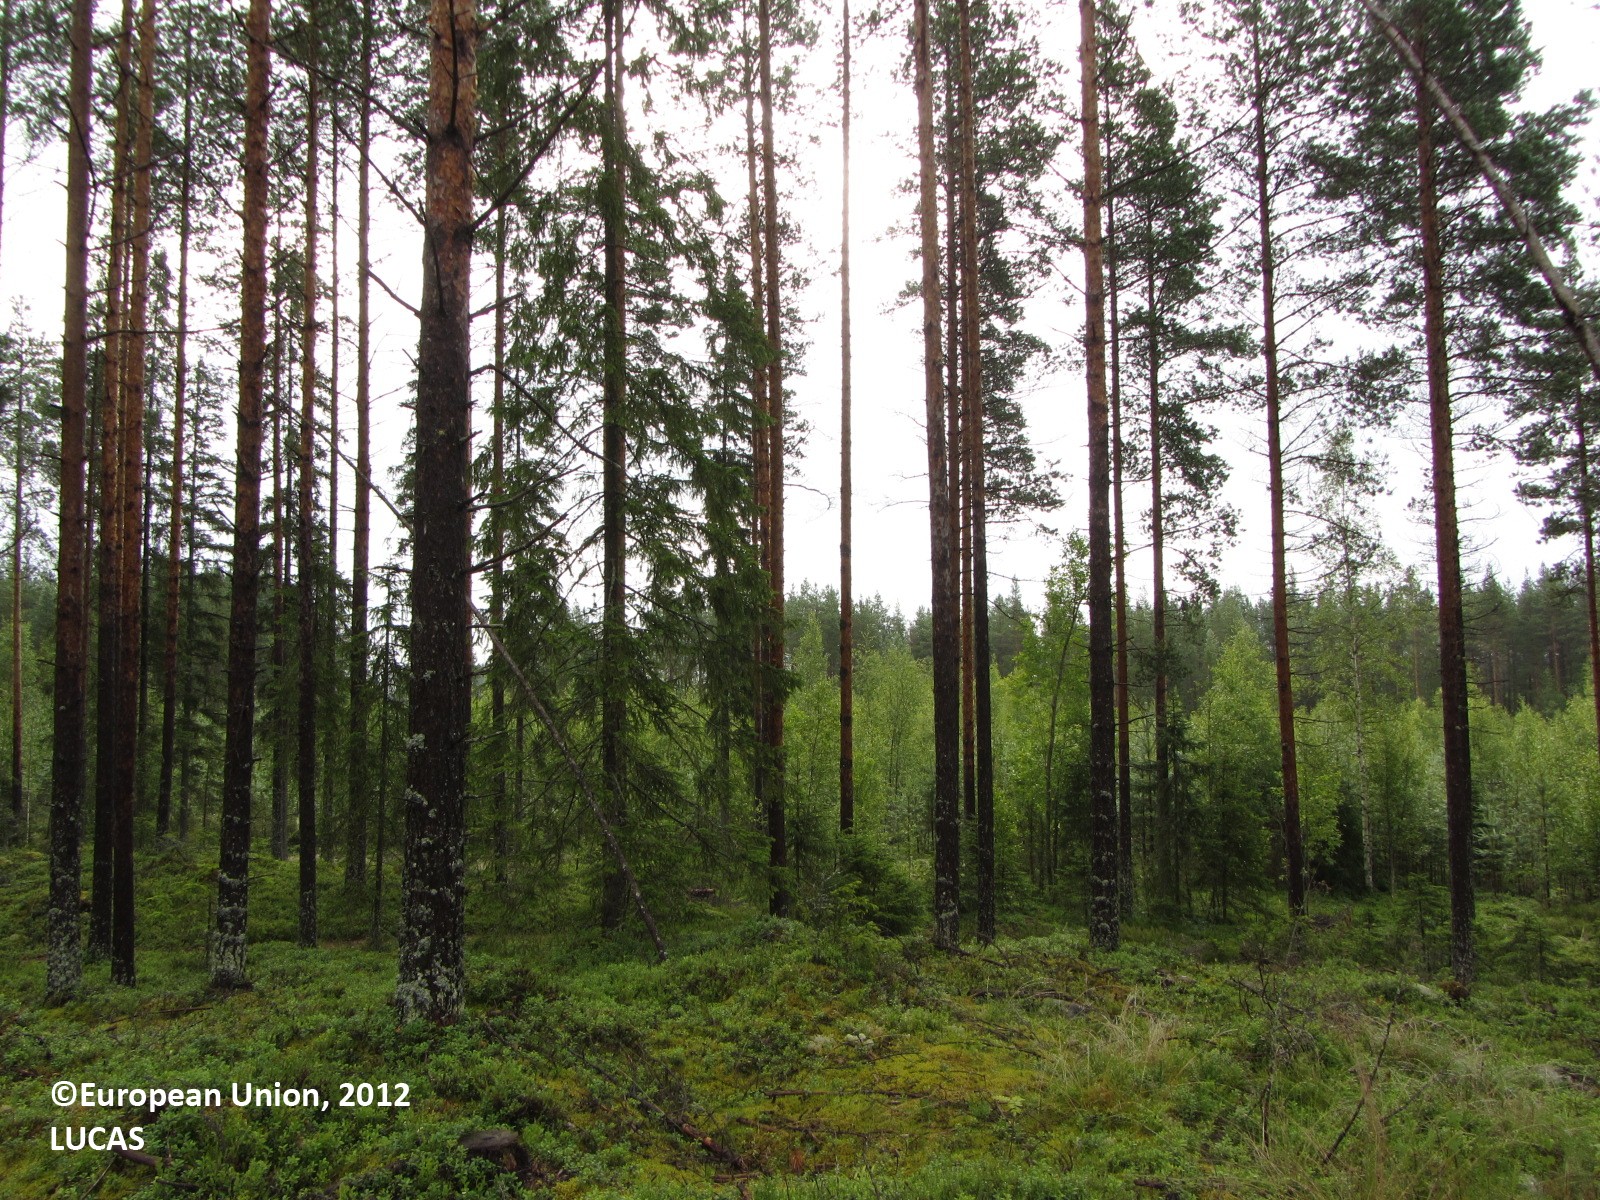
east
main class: Woodland
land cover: Pine dominated coniferous woodland
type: boreal forest
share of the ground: 50 - 75 %
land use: Forestry
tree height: > 5 m
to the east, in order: Pine dominated coniferous woodland; Tracks; Pine dominated coniferous woodland; Tracks; Pine dominated coniferous woodland
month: July
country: FI
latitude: 63.9143
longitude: 24.8608
